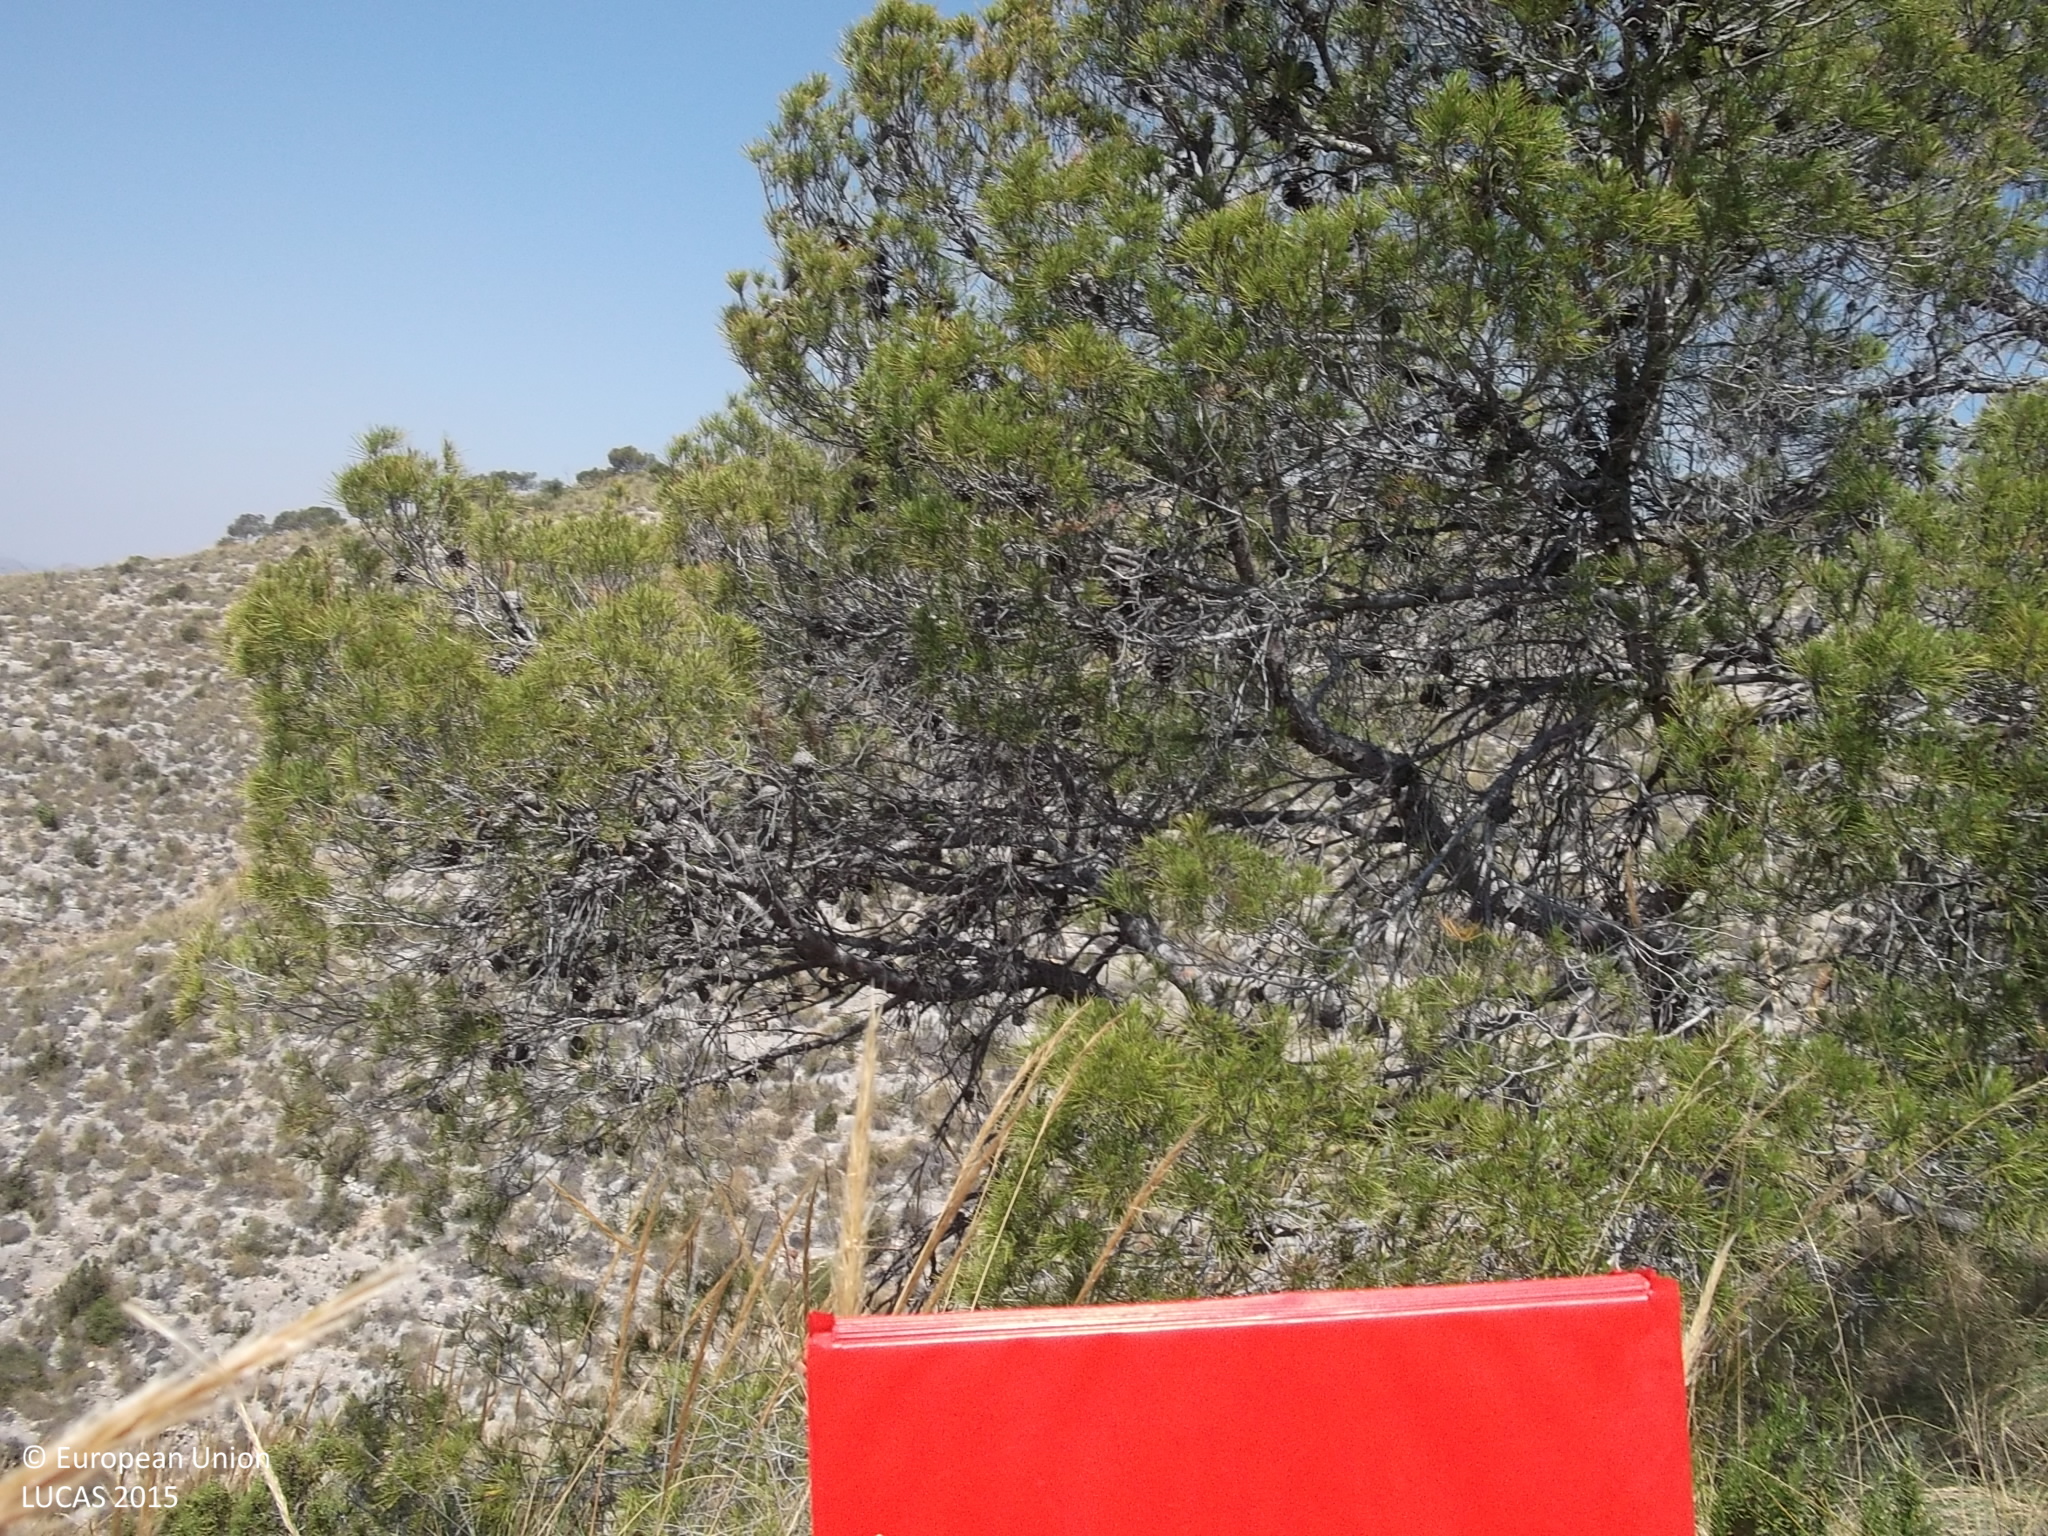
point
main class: Woodland
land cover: Pine dominated coniferous woodland
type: coniferous forest of the mediterranean region
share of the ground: 10 - 25 %
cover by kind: shrubs 30 %, consolidated bare surface 30 %, coniferous forest trees 20 %, herbaceous plants 20 %
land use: Semi-natural and natural areas not in use
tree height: > 5 m
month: May
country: ES
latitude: 38.4452
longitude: -1.4372
